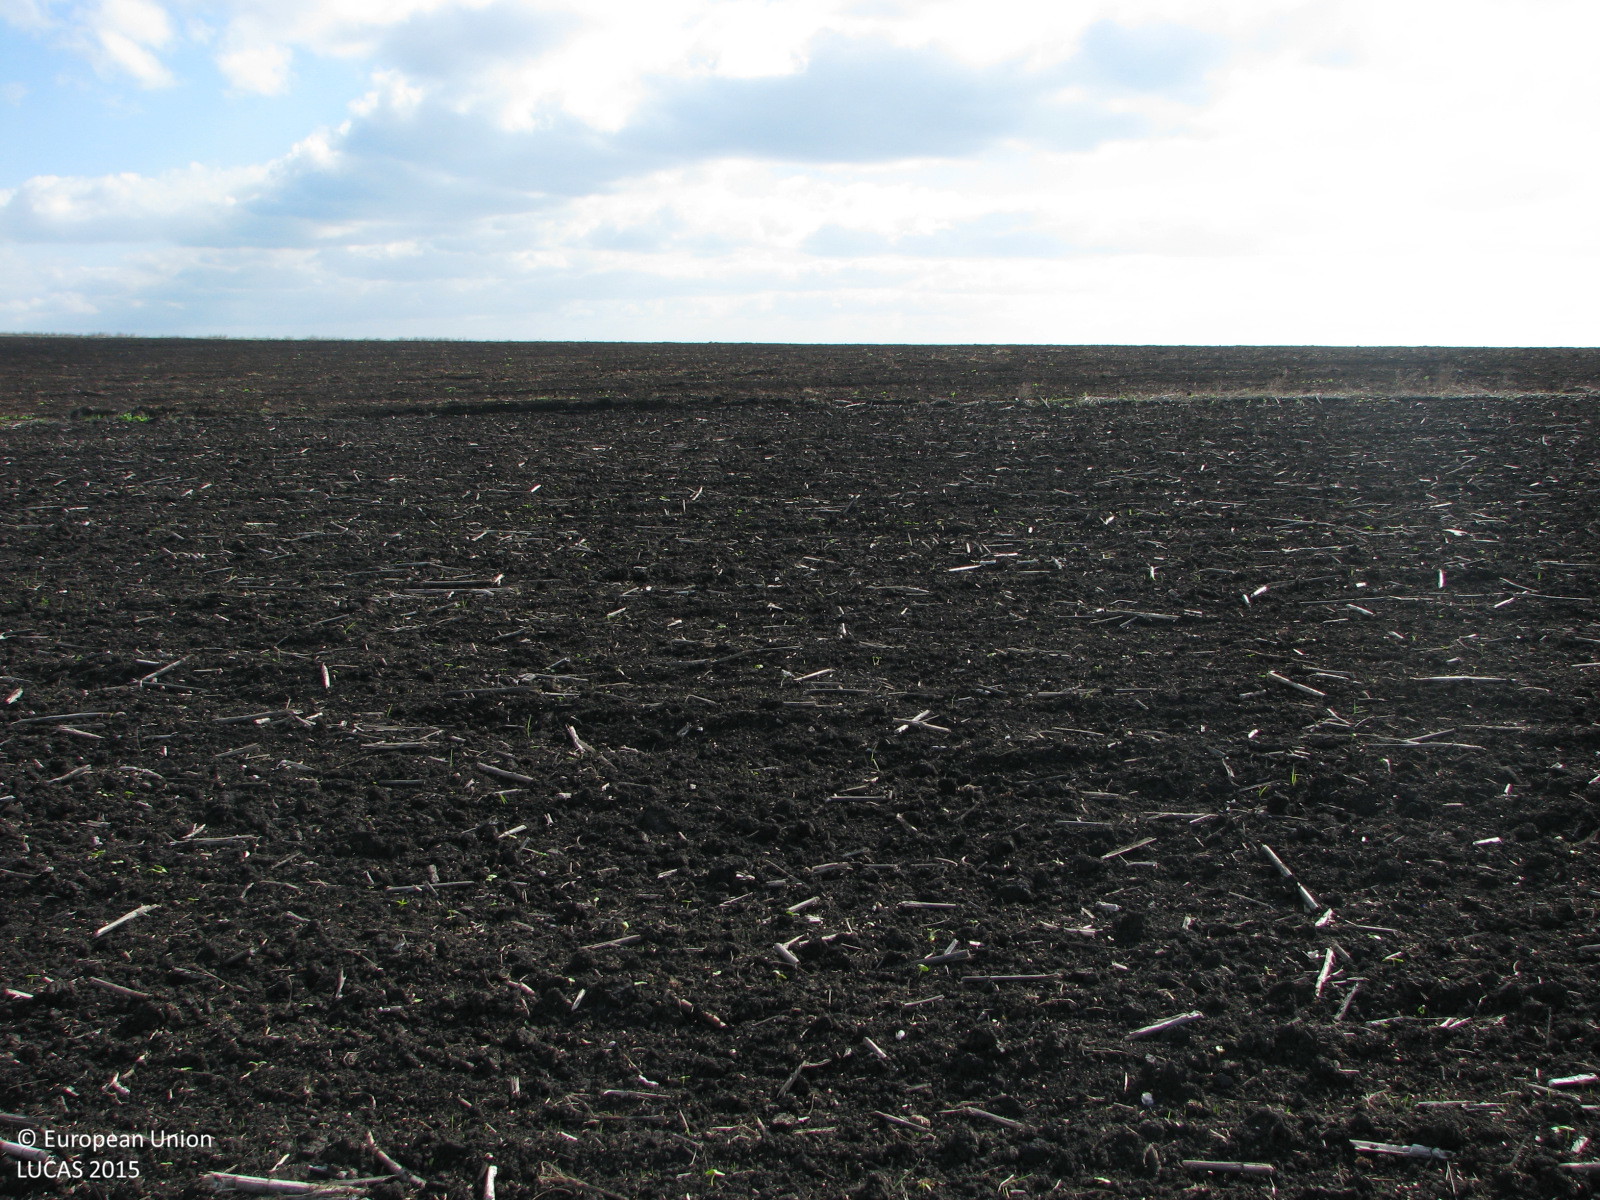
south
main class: Cropland
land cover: Common wheat
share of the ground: < 10 %
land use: Agriculture (excluding fallow land and kitchen gardens)
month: November
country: BG
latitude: 42.4993
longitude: 26.8569
